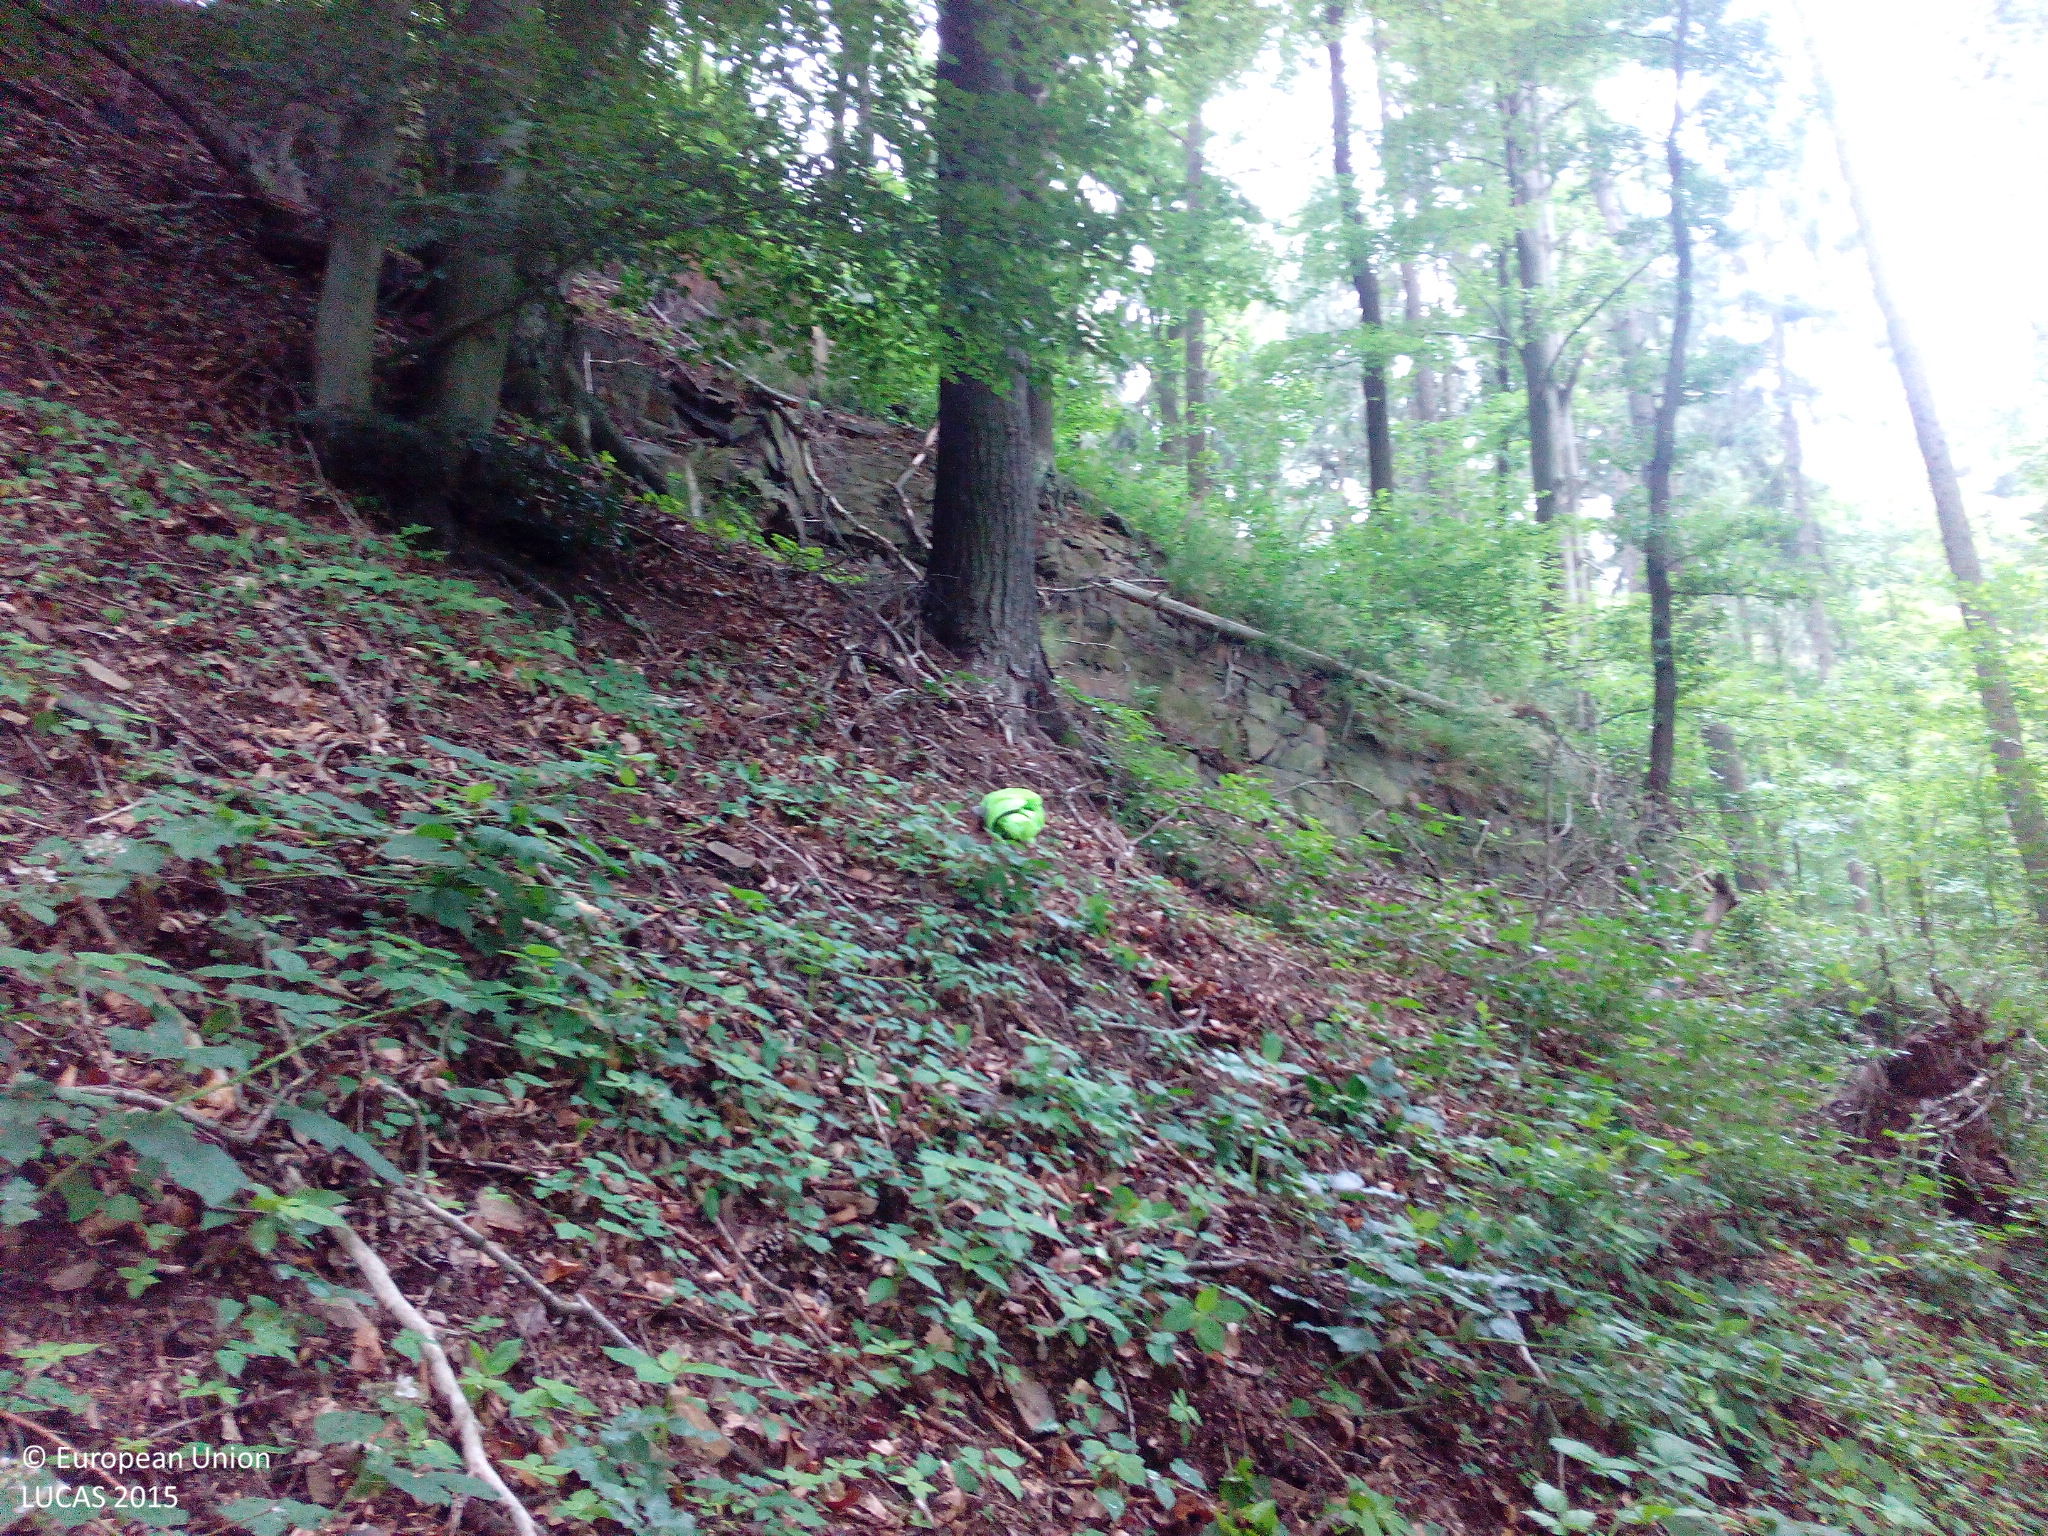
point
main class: Woodland
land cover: Broadleaved woodland
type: mesophytic deciduous forest
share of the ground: > 75 %
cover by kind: broadleaved forest trees 100 %
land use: Forestry
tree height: > 5 m
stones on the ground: < 10 %
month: June
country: DE
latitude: 50.9544
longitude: 13.0038
